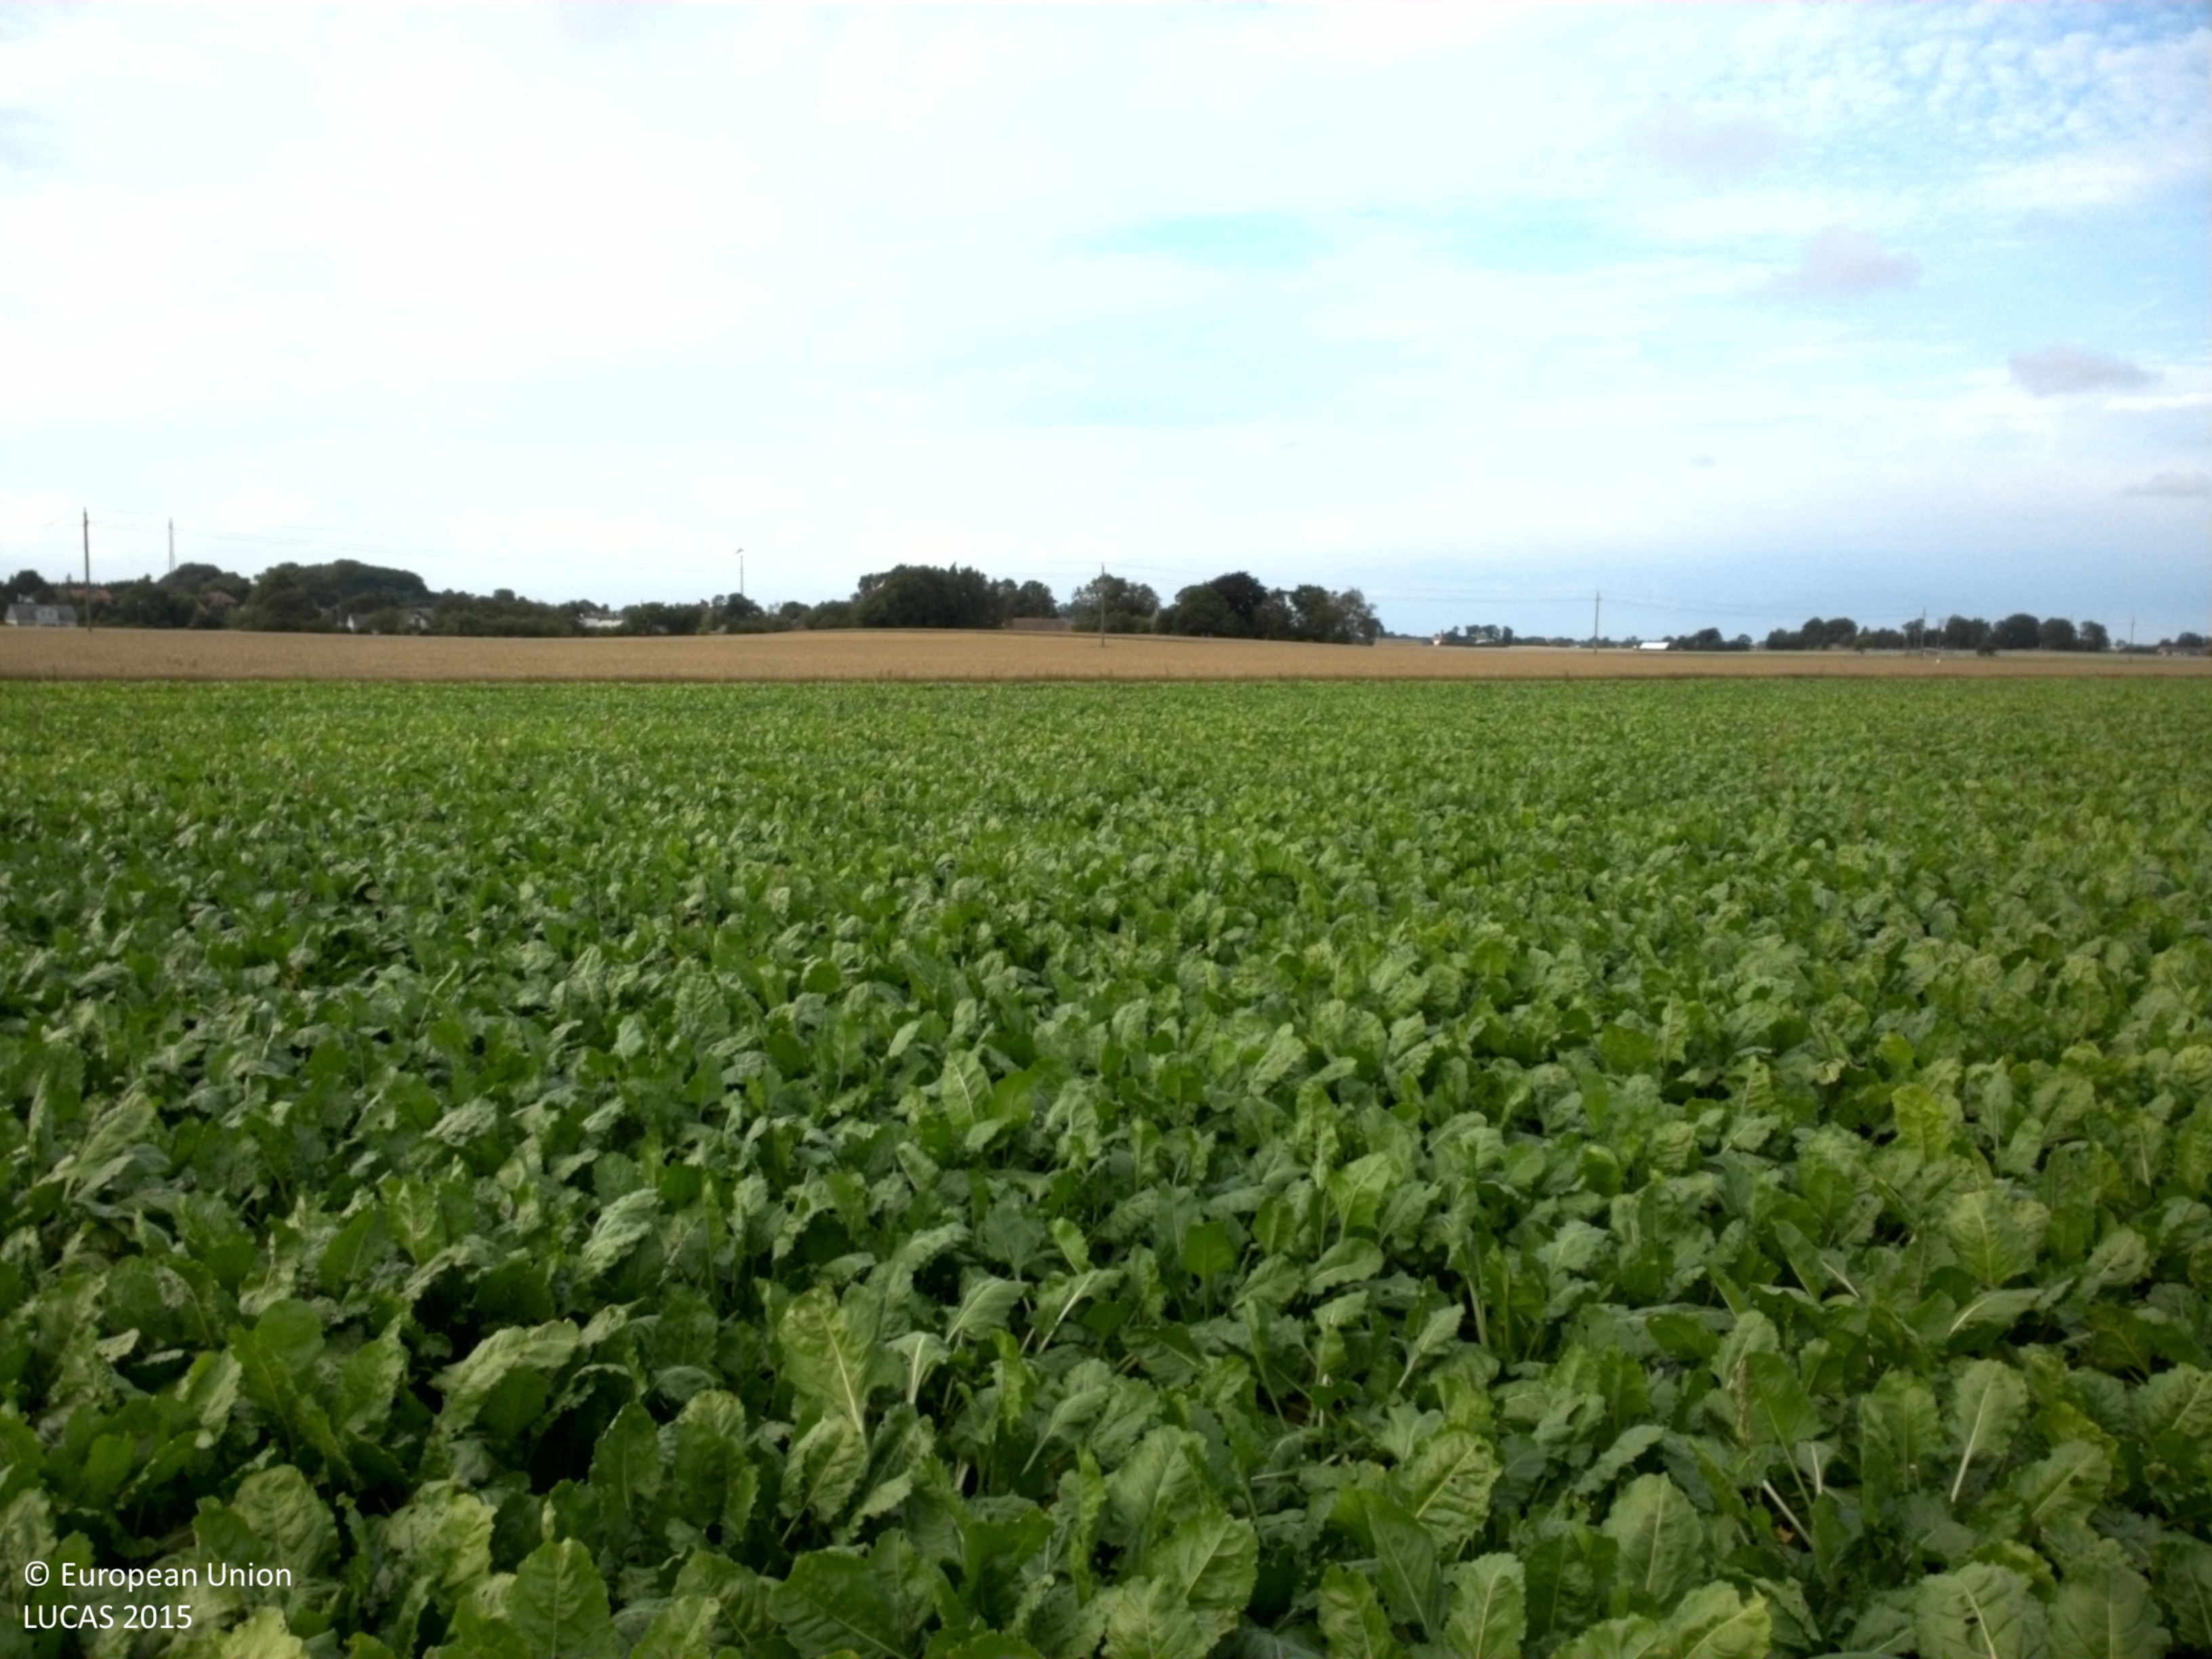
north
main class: Cropland
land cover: Sugar beet
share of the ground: > 75 %
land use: Agriculture (excluding fallow land and kitchen gardens)
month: September
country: SE
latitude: 55.4534
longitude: 14.1889
